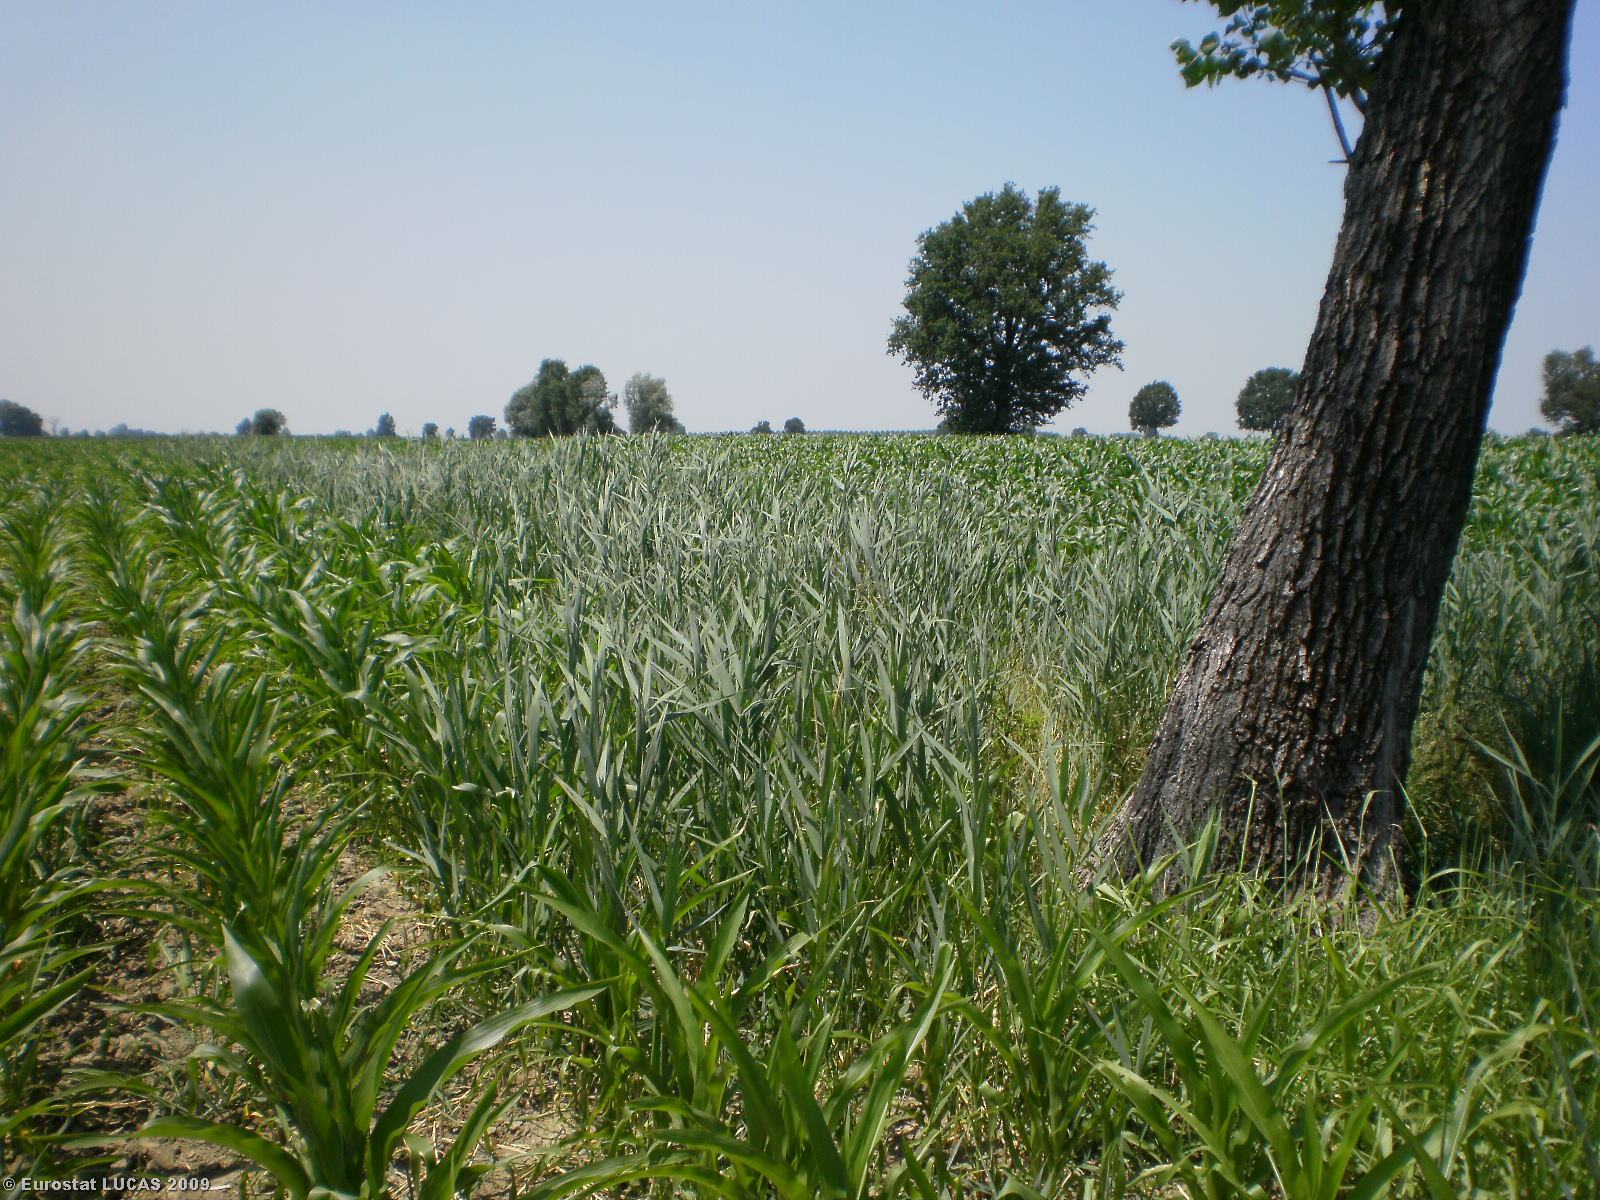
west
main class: Woodland
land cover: Broadleaved woodland
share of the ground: > 75 %
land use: Unused
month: June
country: IT
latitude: 45.0352
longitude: 10.3421
